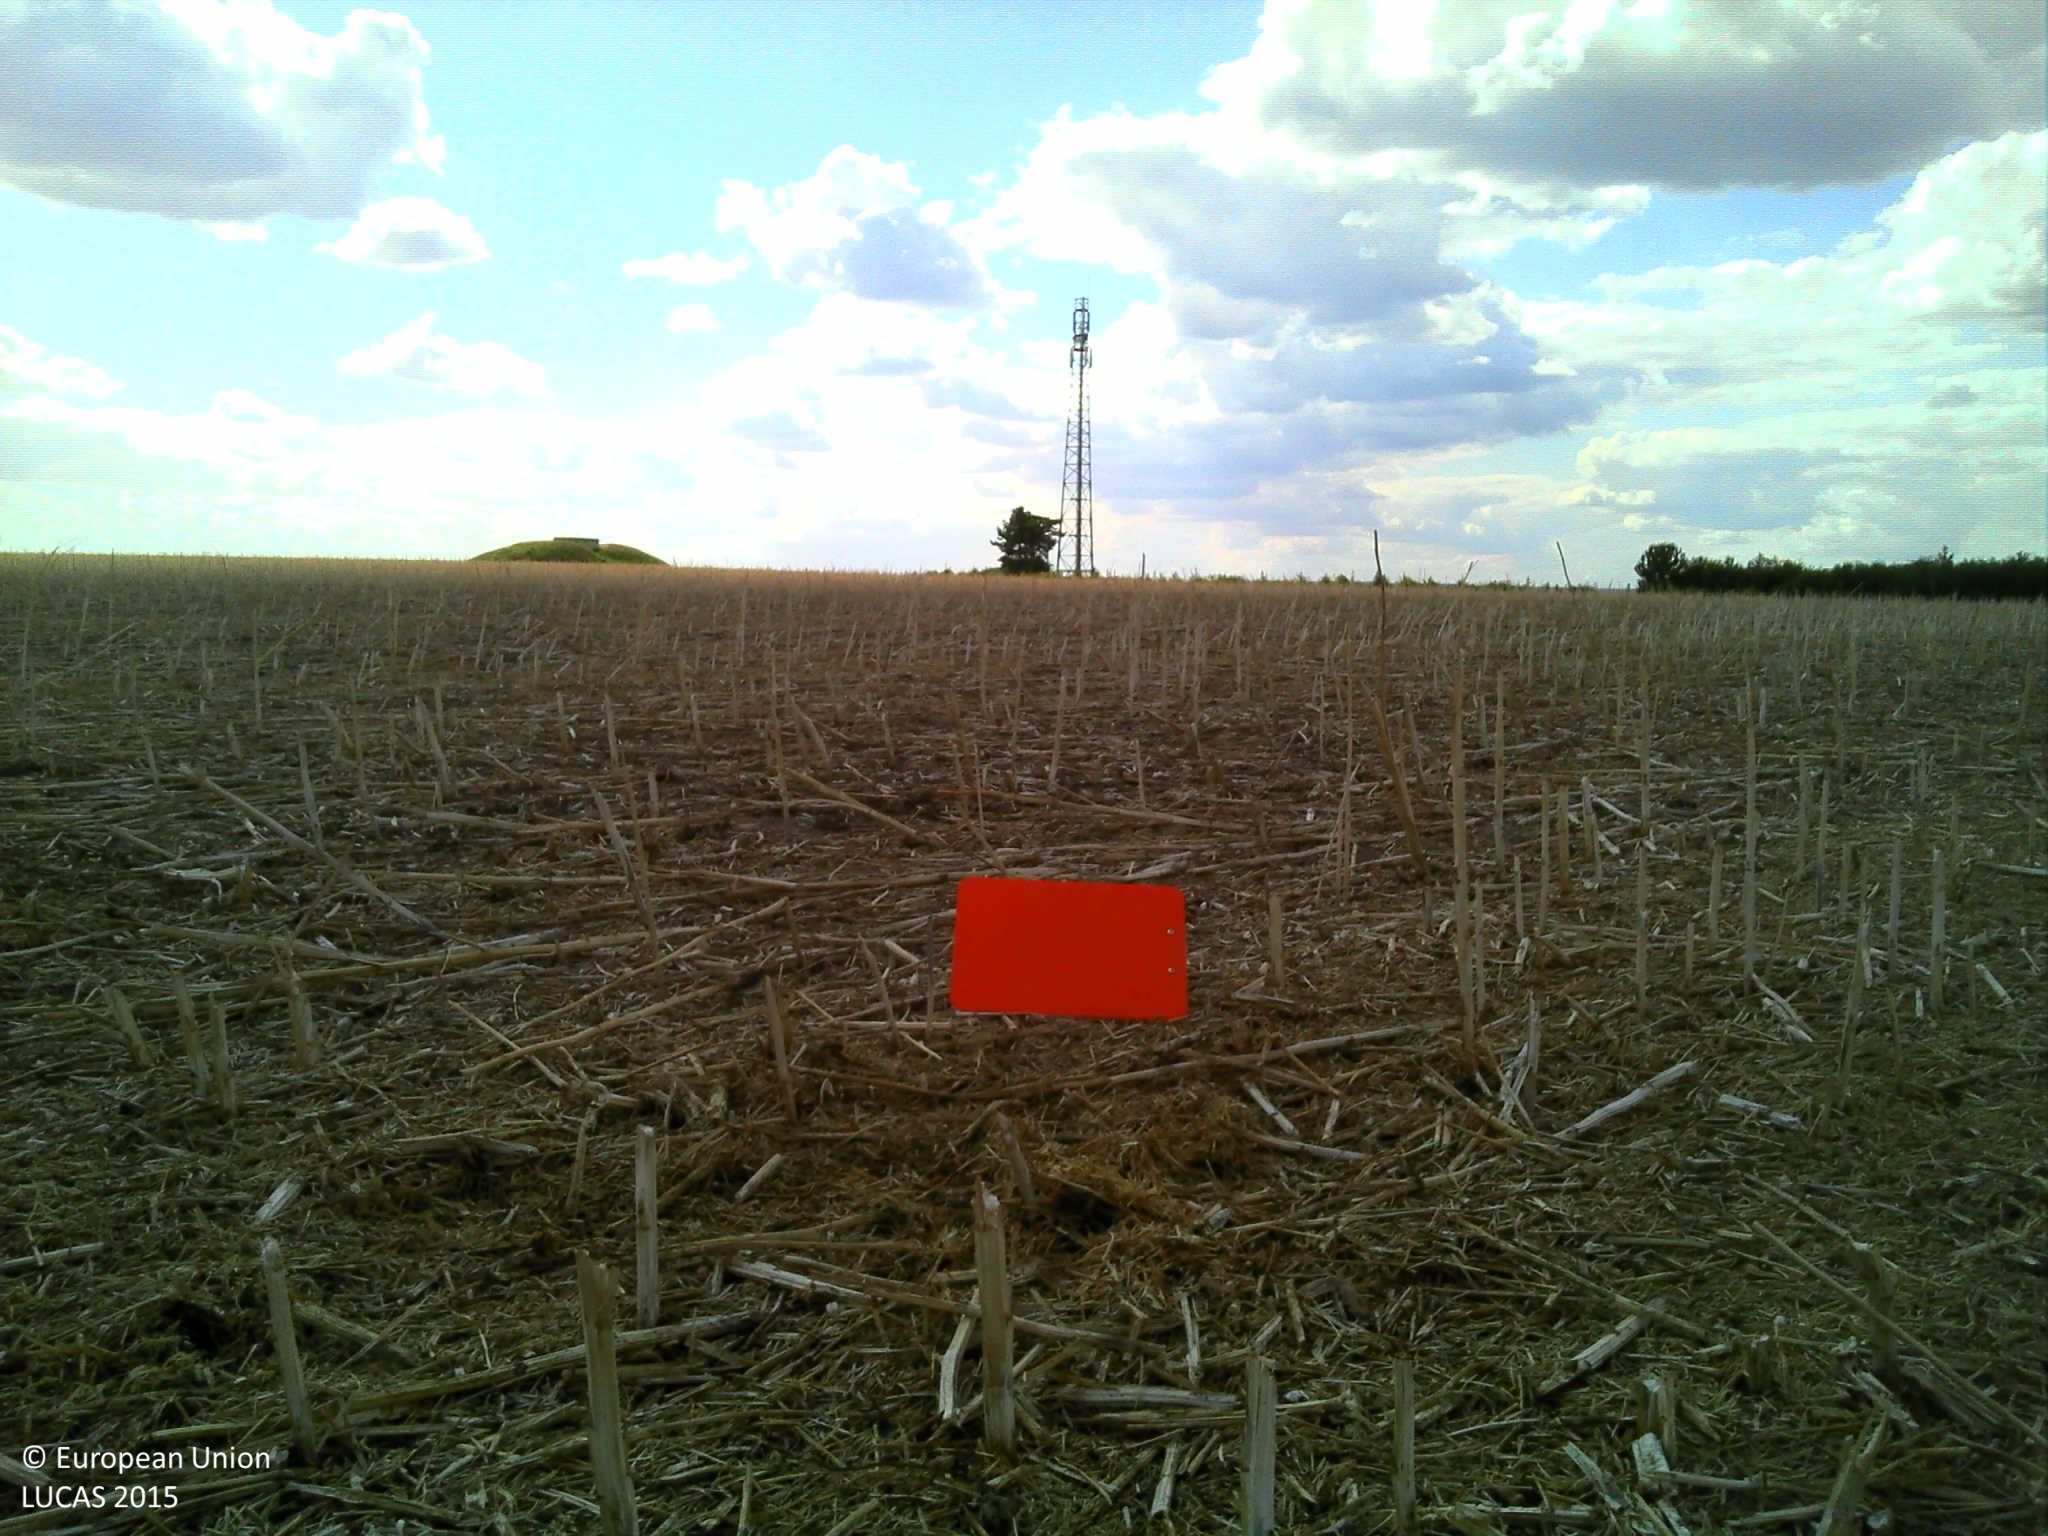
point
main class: Cropland
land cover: Rape and turnip rape
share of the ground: > 75 %
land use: Agriculture (excluding fallow land and kitchen gardens)
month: July
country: FR
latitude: 48.9156
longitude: 4.1417
